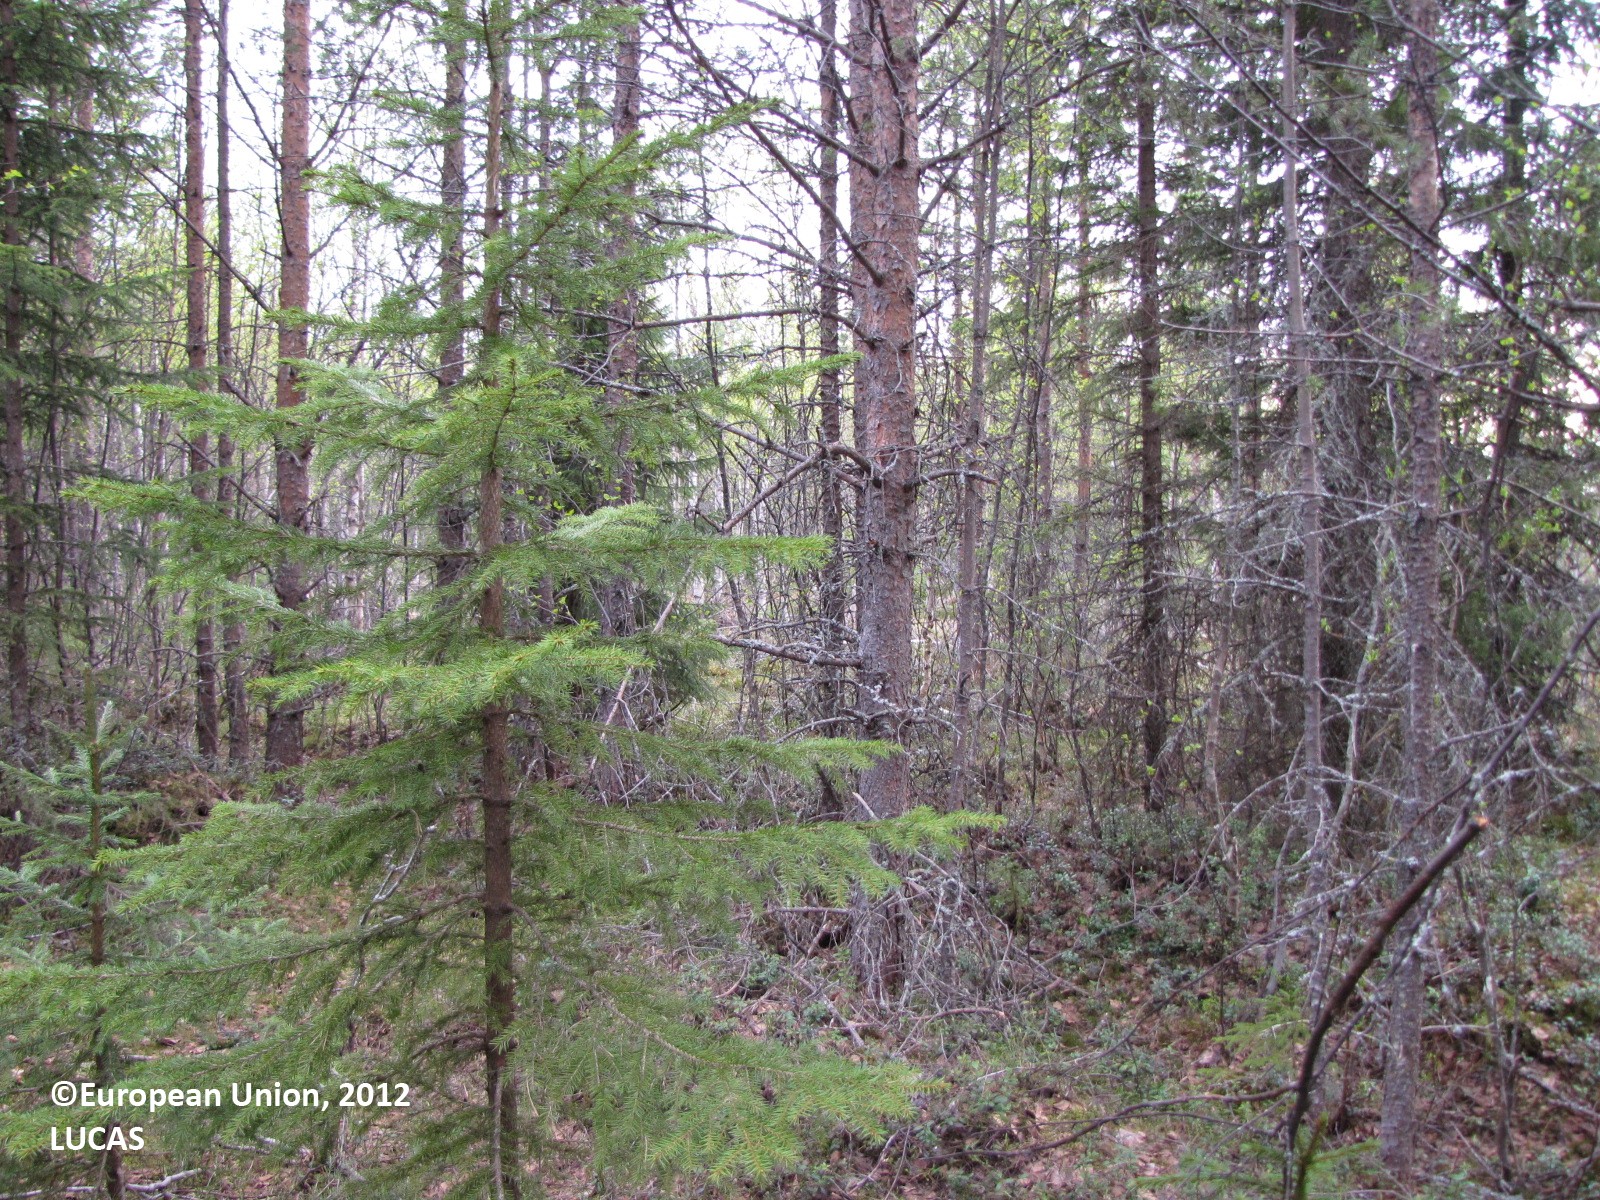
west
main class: Woodland
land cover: Other mixed woodland
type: boreal forest
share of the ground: > 75 %
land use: Forestry
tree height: > 5 m
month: May
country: FI
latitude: 65.7218
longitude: 24.6833
